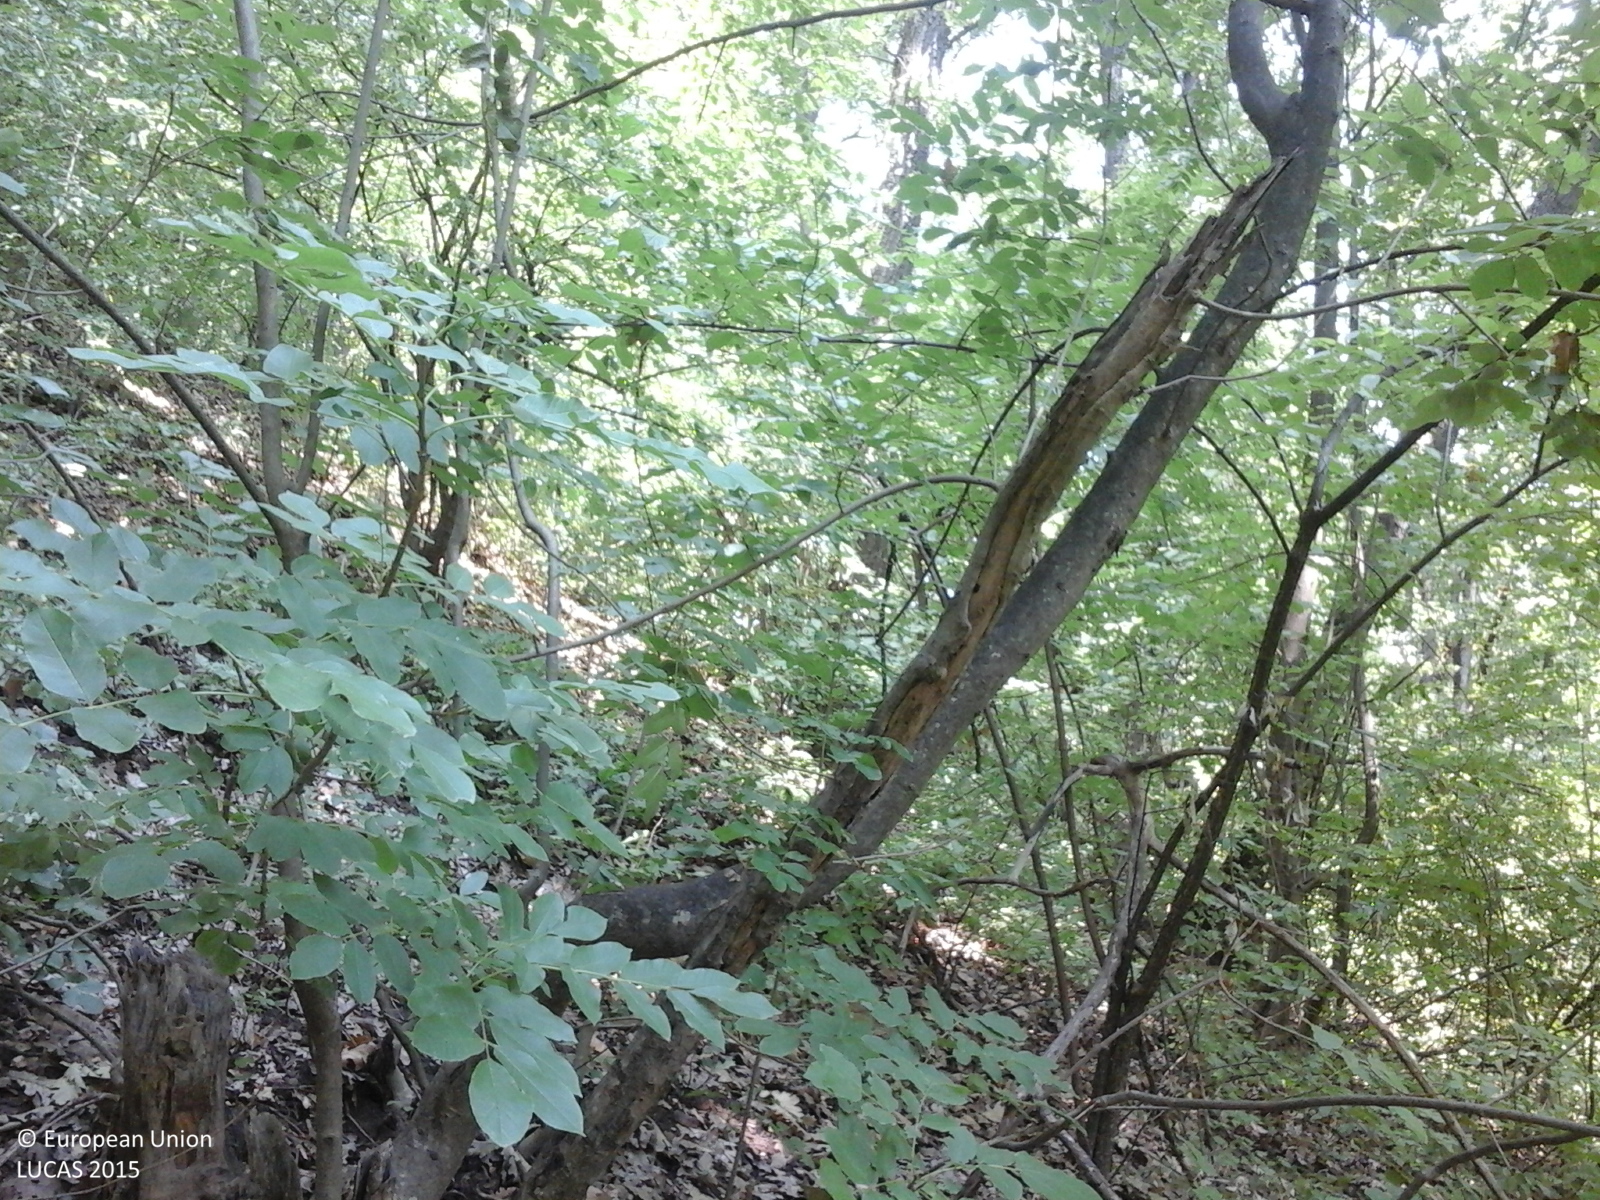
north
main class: Woodland
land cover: Broadleaved woodland
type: mesophytic deciduous forest
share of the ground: > 75 %
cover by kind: broadleaved forest trees 100 %
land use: Forestry
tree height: > 5 m
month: August
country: RO
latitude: 44.7009
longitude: 23.1108
